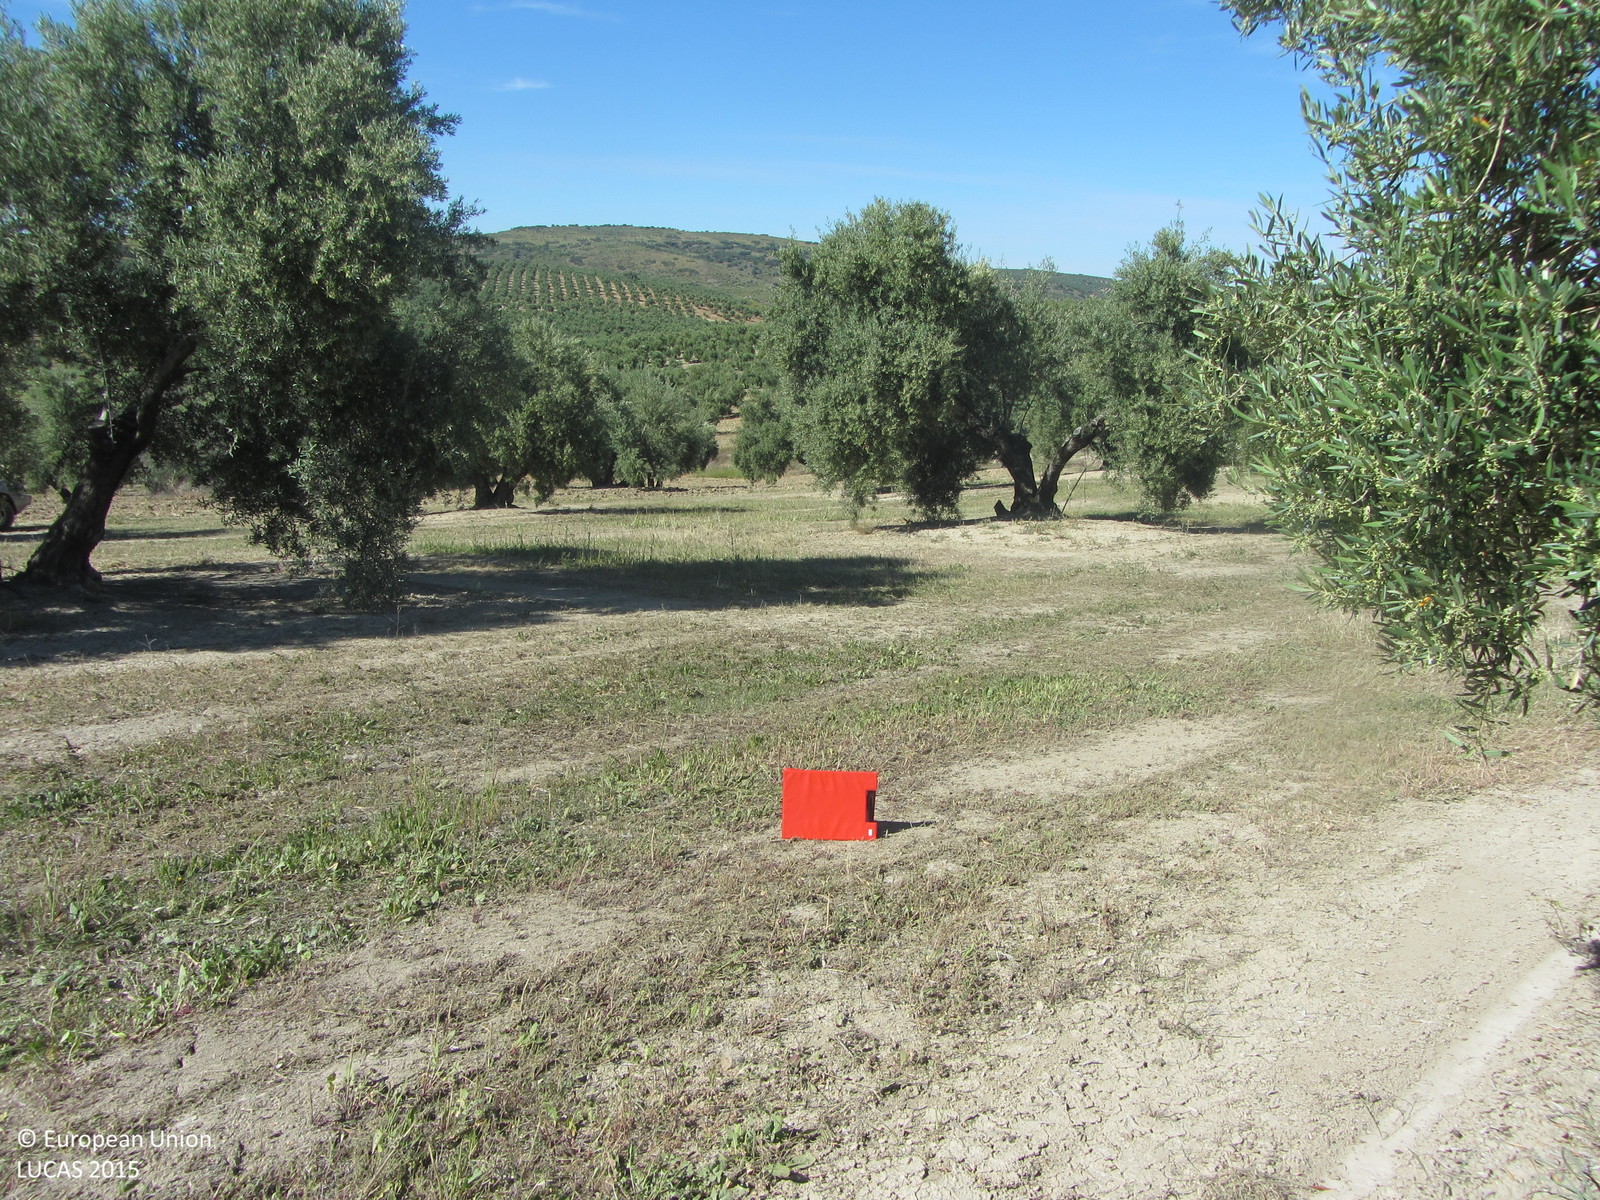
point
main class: Cropland
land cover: Olive groves
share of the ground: 25 - 50 %
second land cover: Spontaneously vegetated surfaces
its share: 50 - 75 %
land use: Agriculture (excluding fallow land and kitchen gardens)
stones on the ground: < 10 %
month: May
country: ES
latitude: 38.0763
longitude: -3.4190
